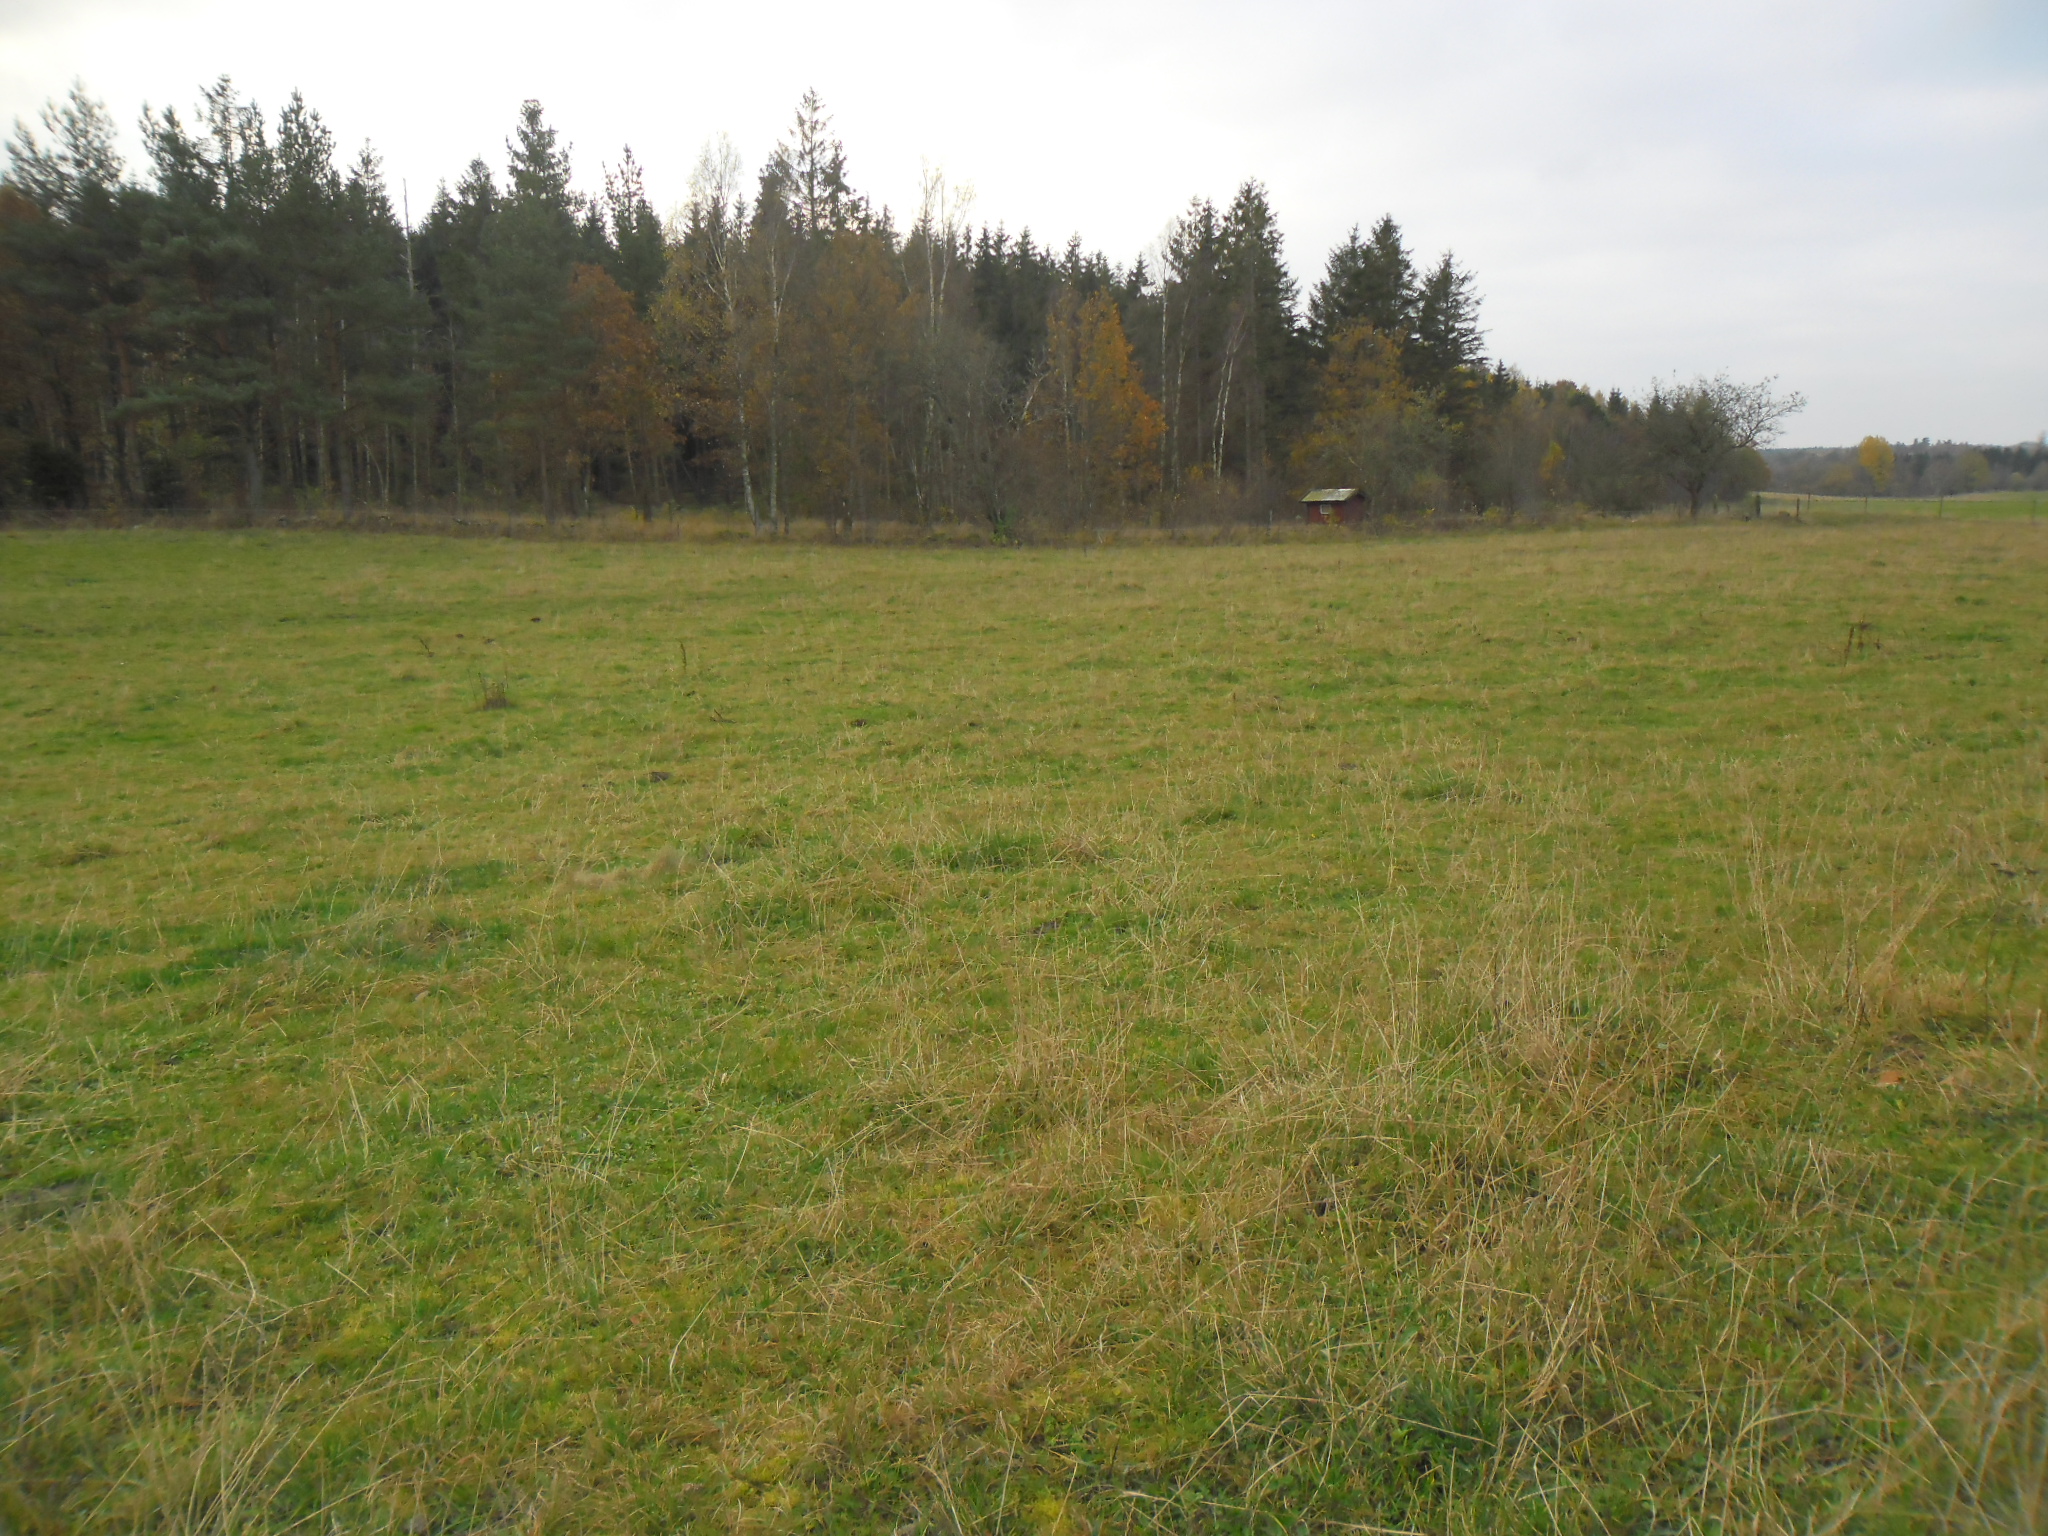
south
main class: Cropland
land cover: Temporary grasslands
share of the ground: > 75 %
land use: Agriculture (excluding fallow land and kitchen gardens)
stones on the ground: 25 - 50 %
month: October
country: SE
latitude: 56.5258
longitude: 13.1995
